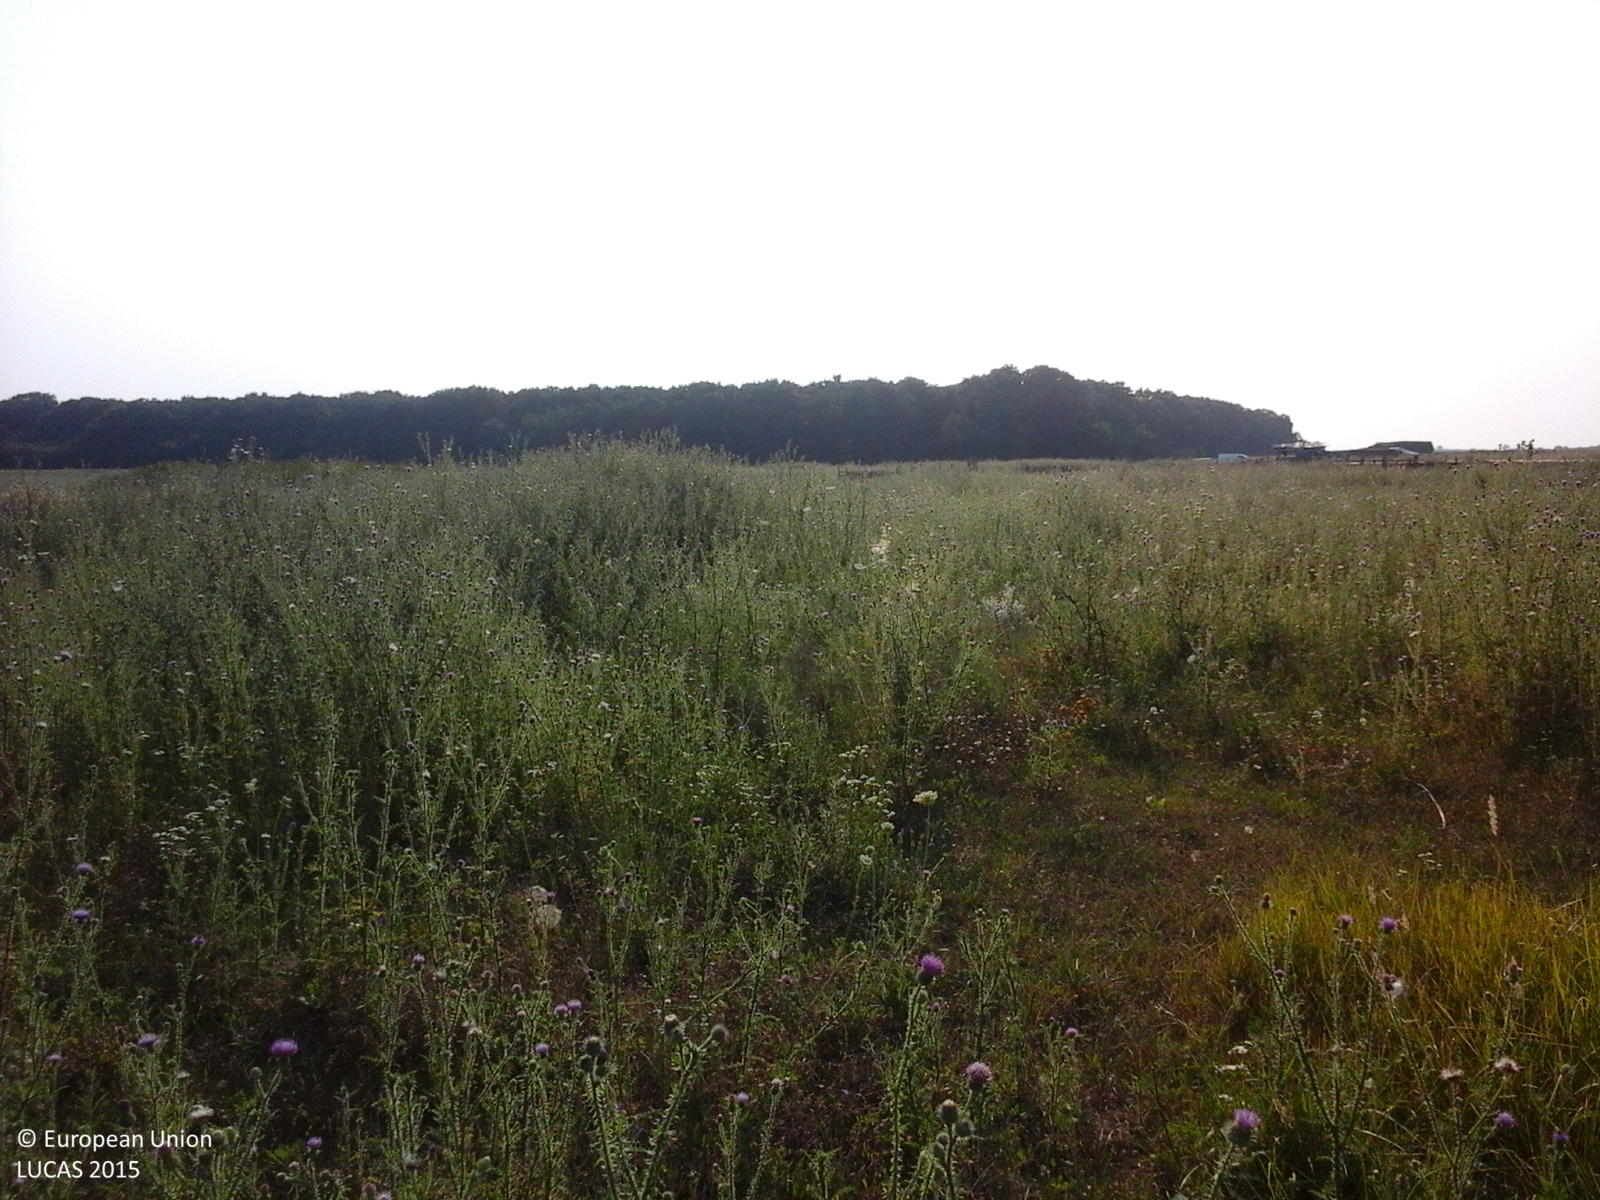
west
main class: Grassland
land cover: Spontaneously vegetated surfaces
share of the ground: > 75 %
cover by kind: herbaceous plants 100 %
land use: Fallow land
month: July
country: RO
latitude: 44.4753
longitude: 26.4704
